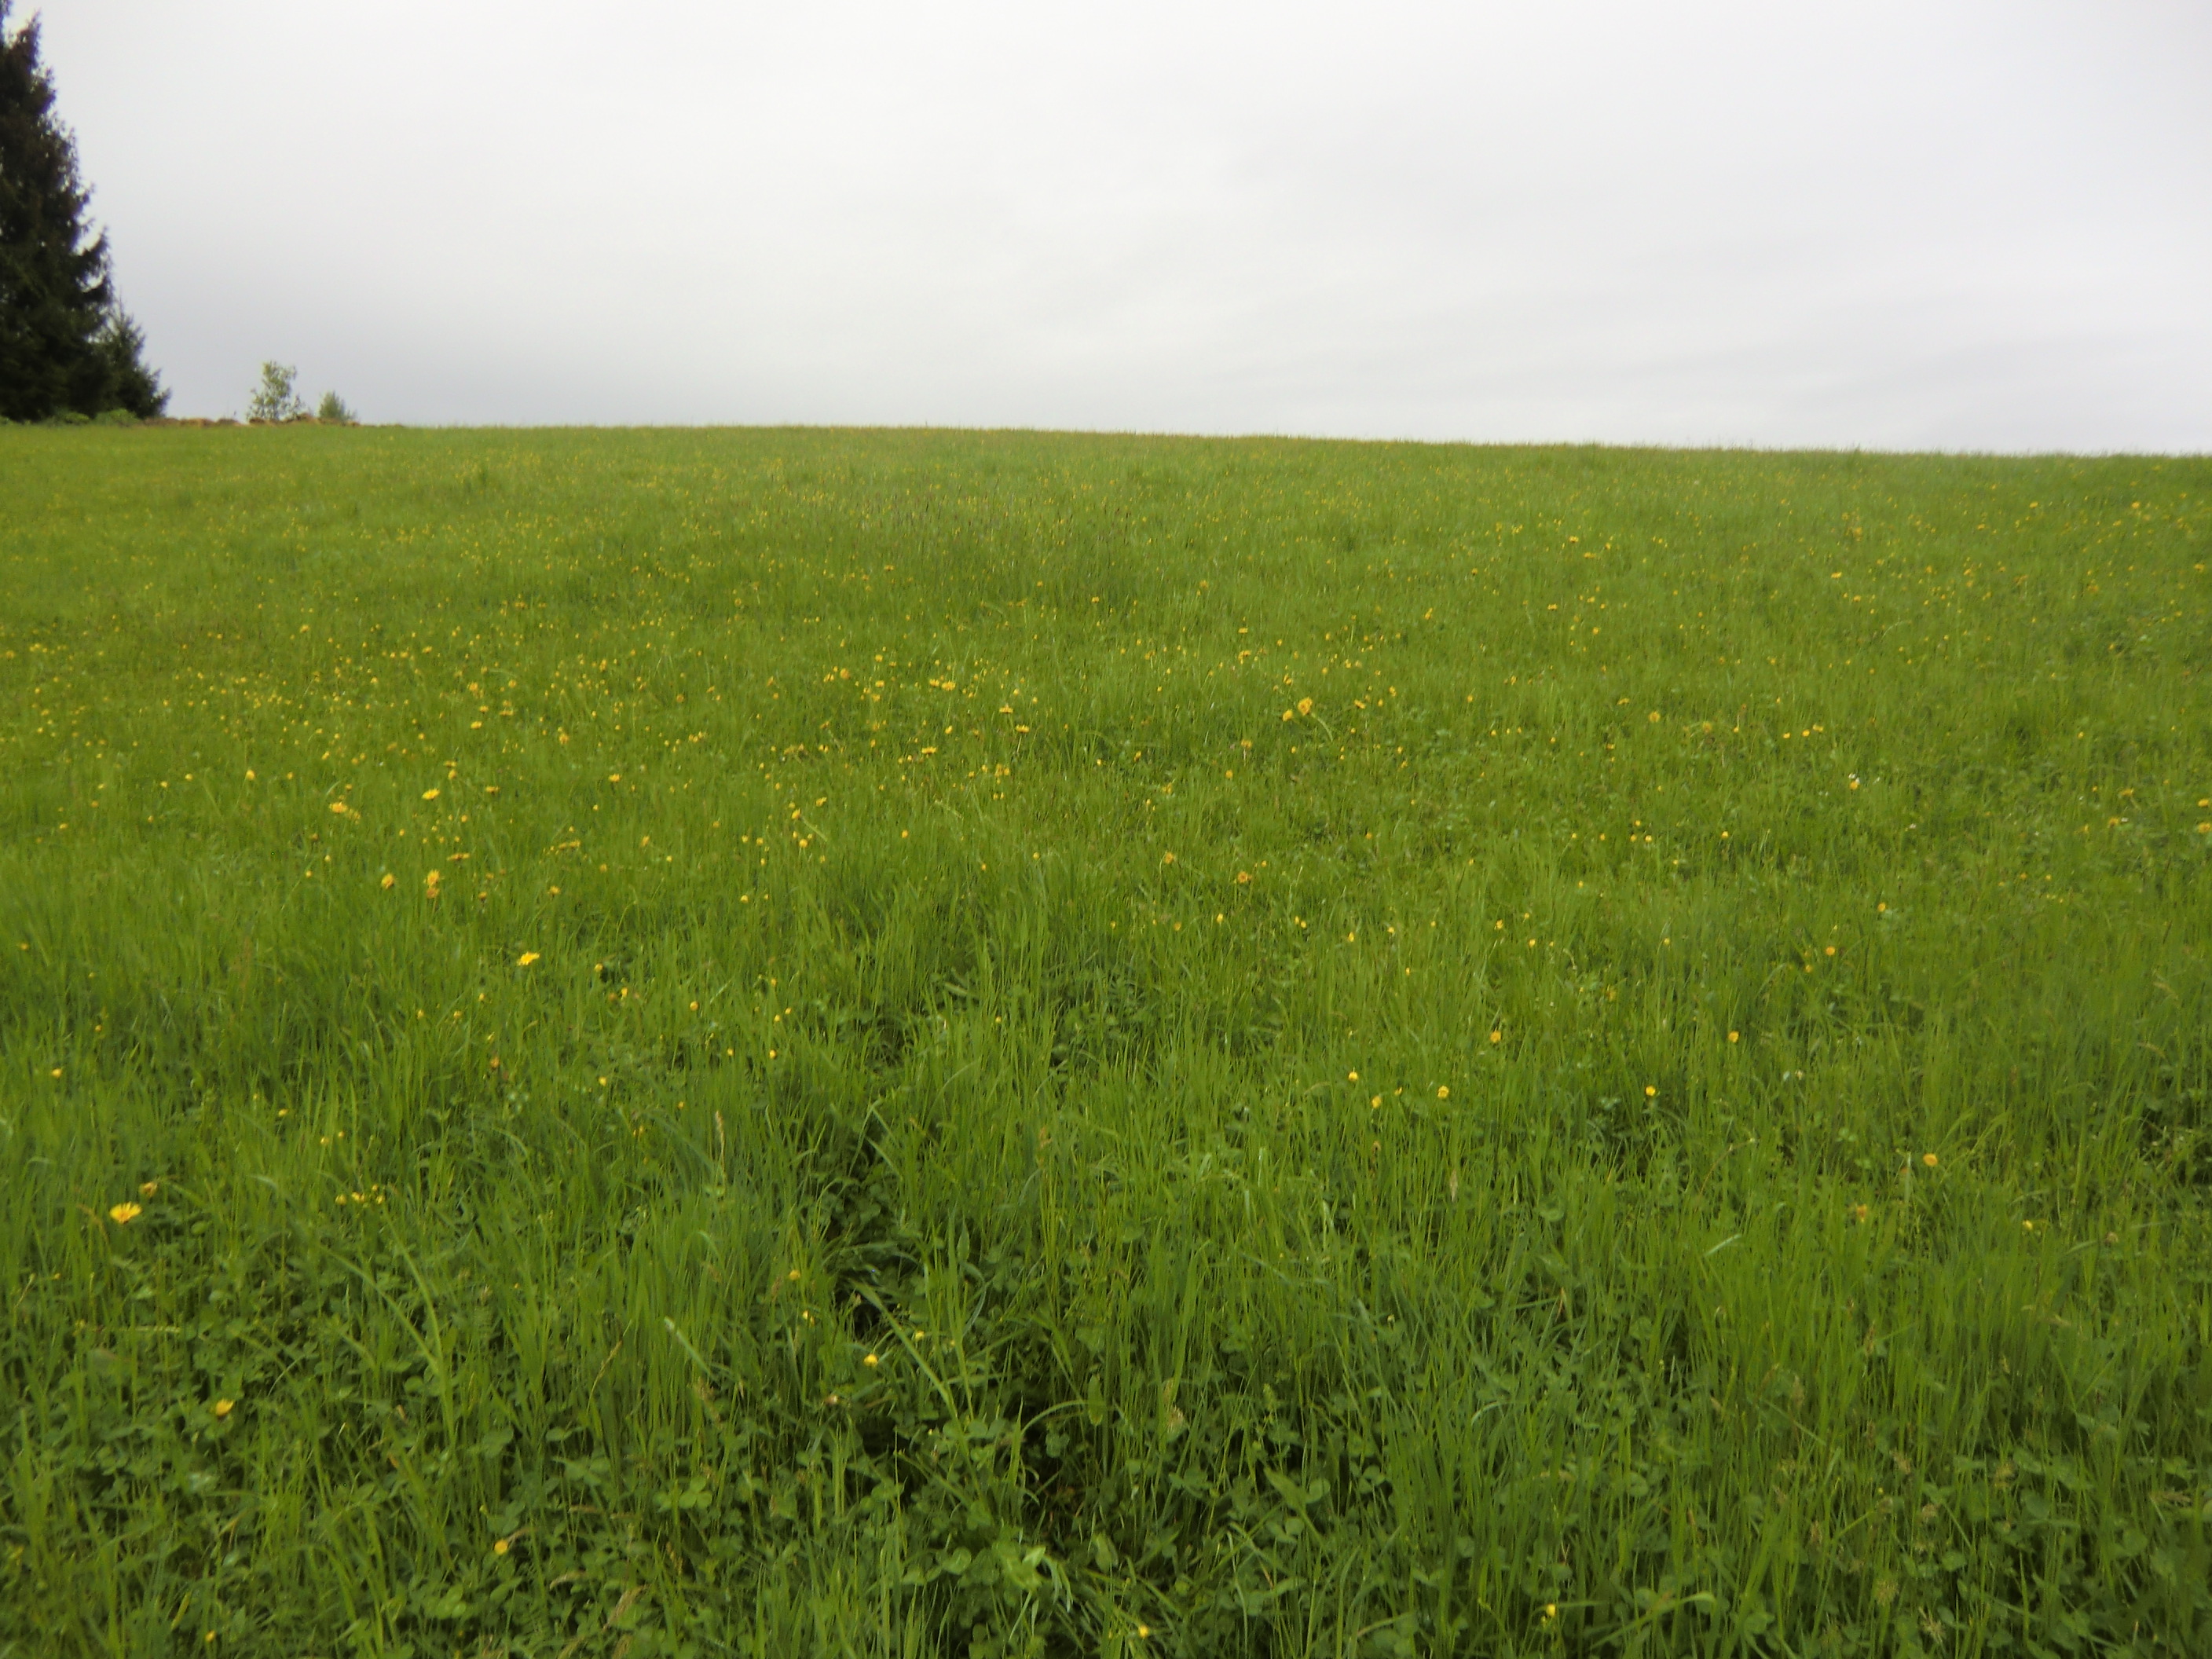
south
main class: Grassland
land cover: Grassland without tree/shrub cover
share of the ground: > 75 %
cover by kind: herbaceous plants 100 %
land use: Agriculture (excluding fallow land and kitchen gardens)
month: May
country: AT
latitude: 48.2854
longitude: 14.7042
